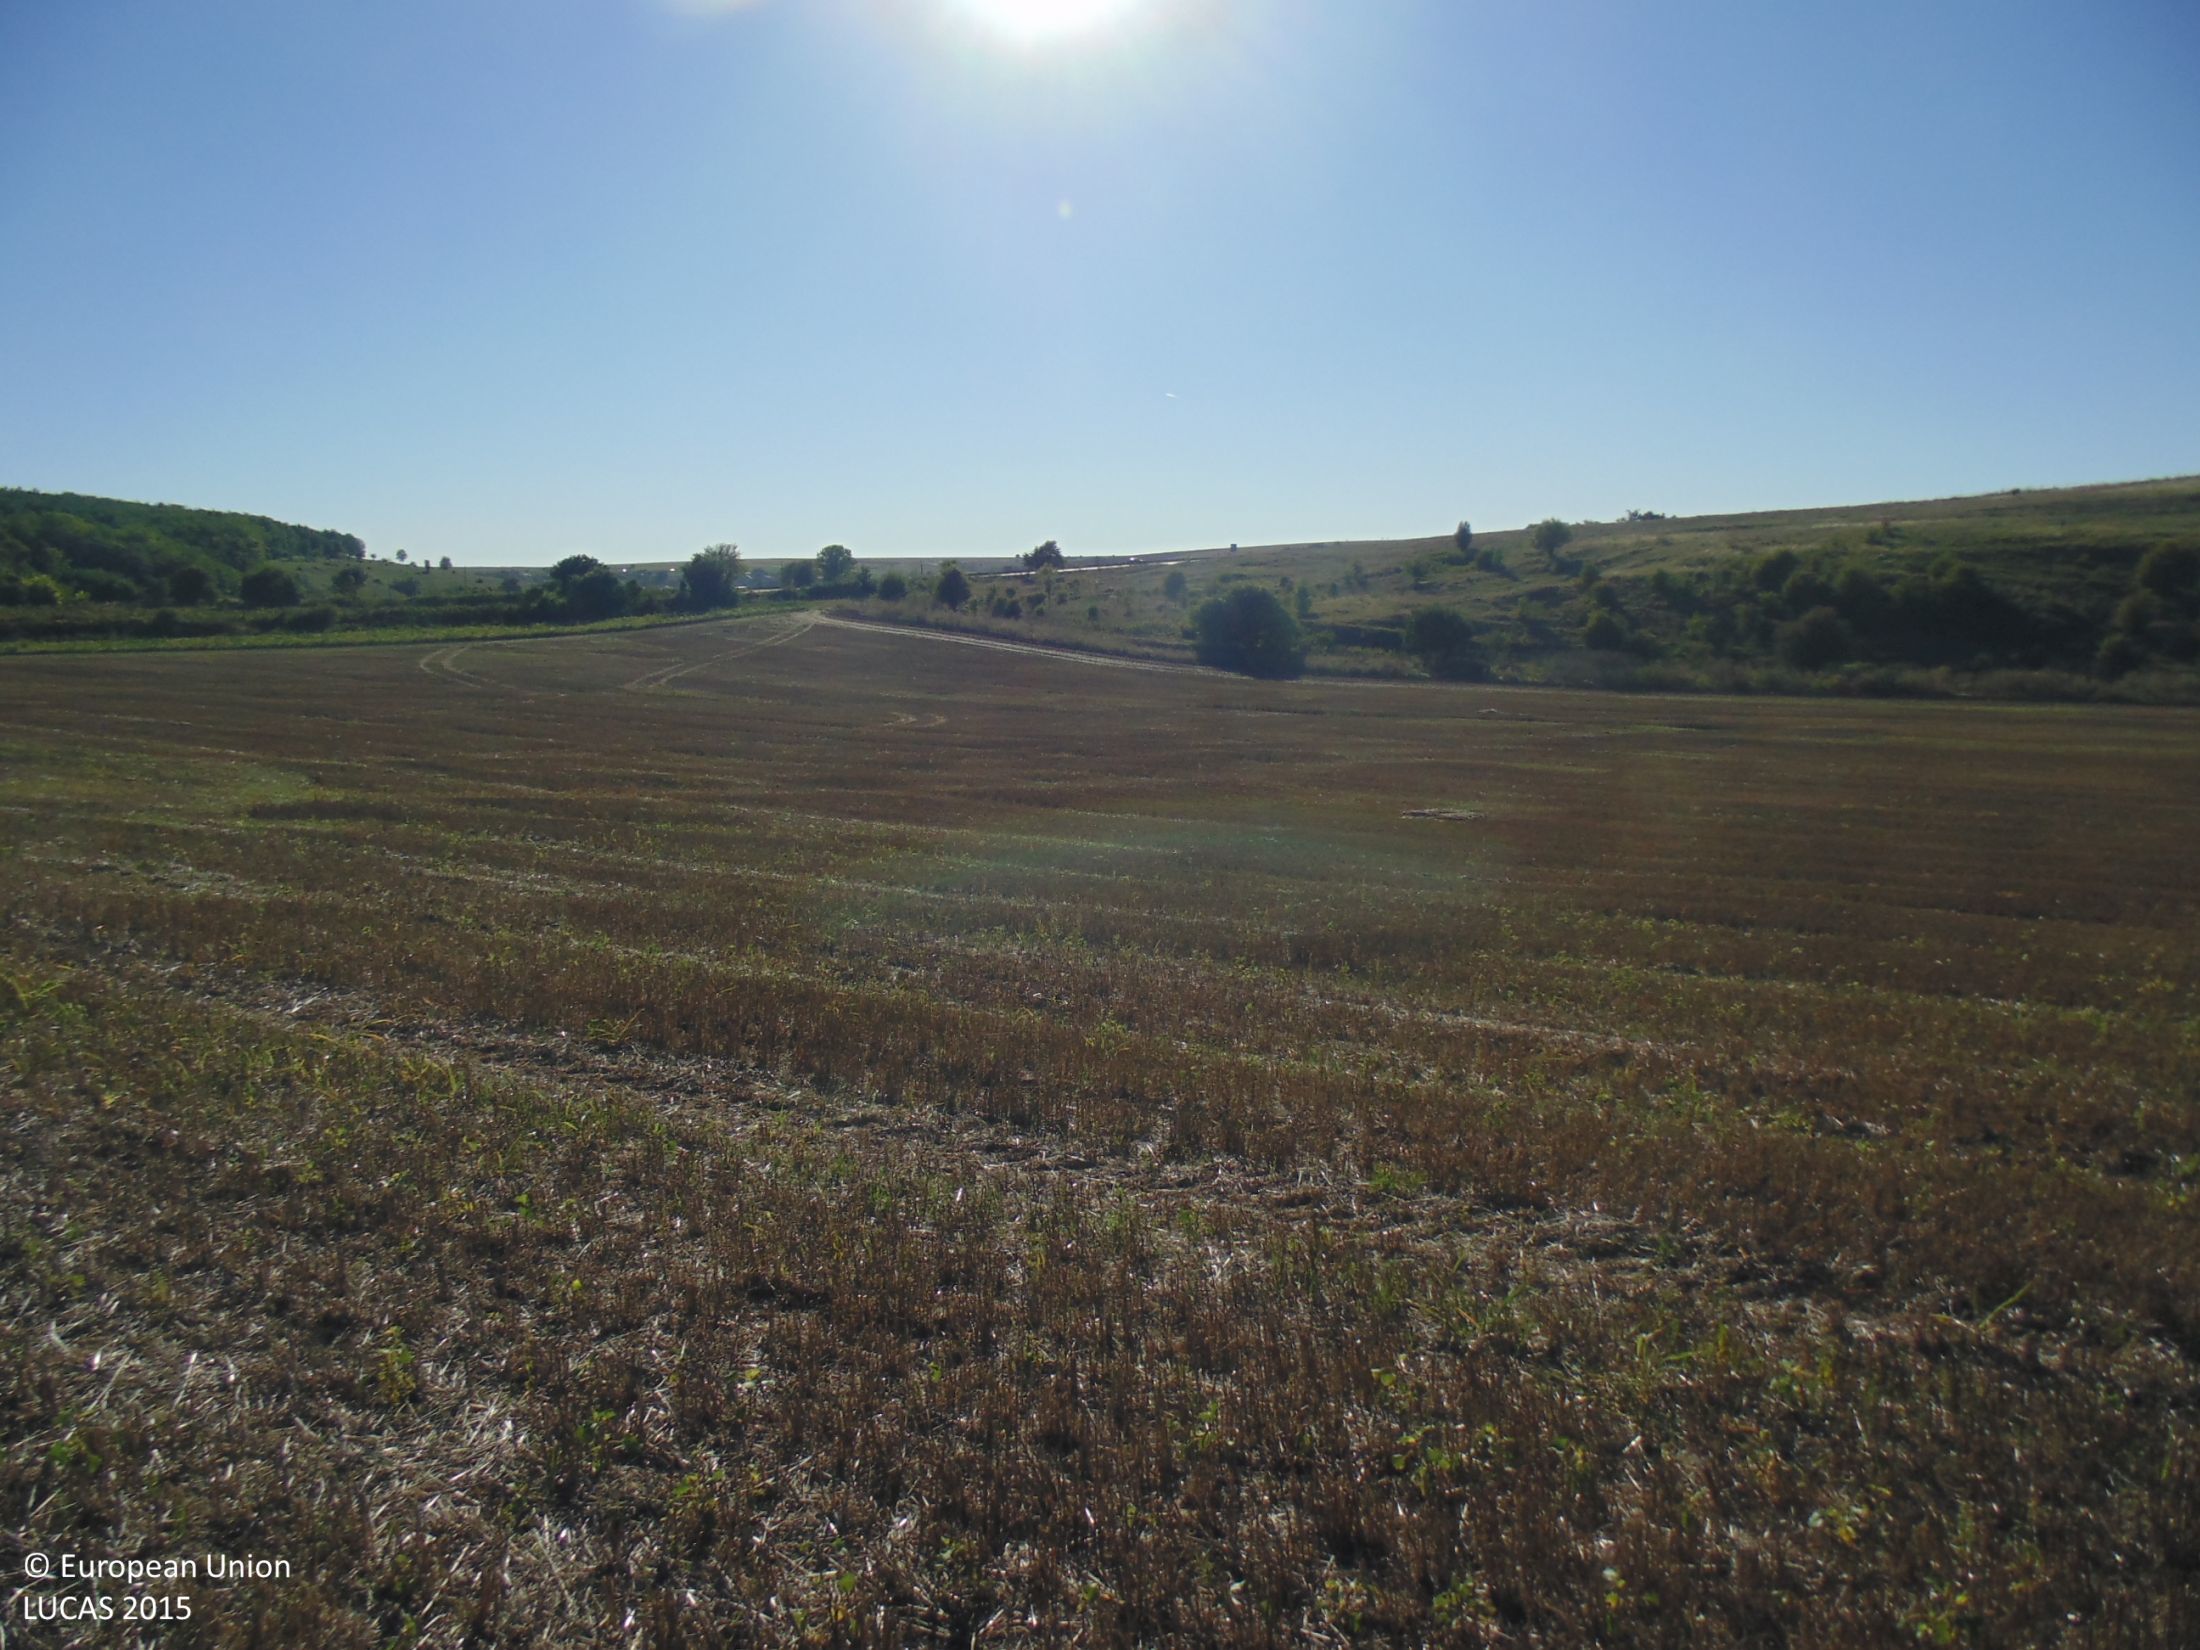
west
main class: Cropland
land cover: Common wheat
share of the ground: 25 - 50 %
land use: Agriculture (excluding fallow land and kitchen gardens)
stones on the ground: < 10 %
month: September
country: BG
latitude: 43.8004
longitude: 27.2171
